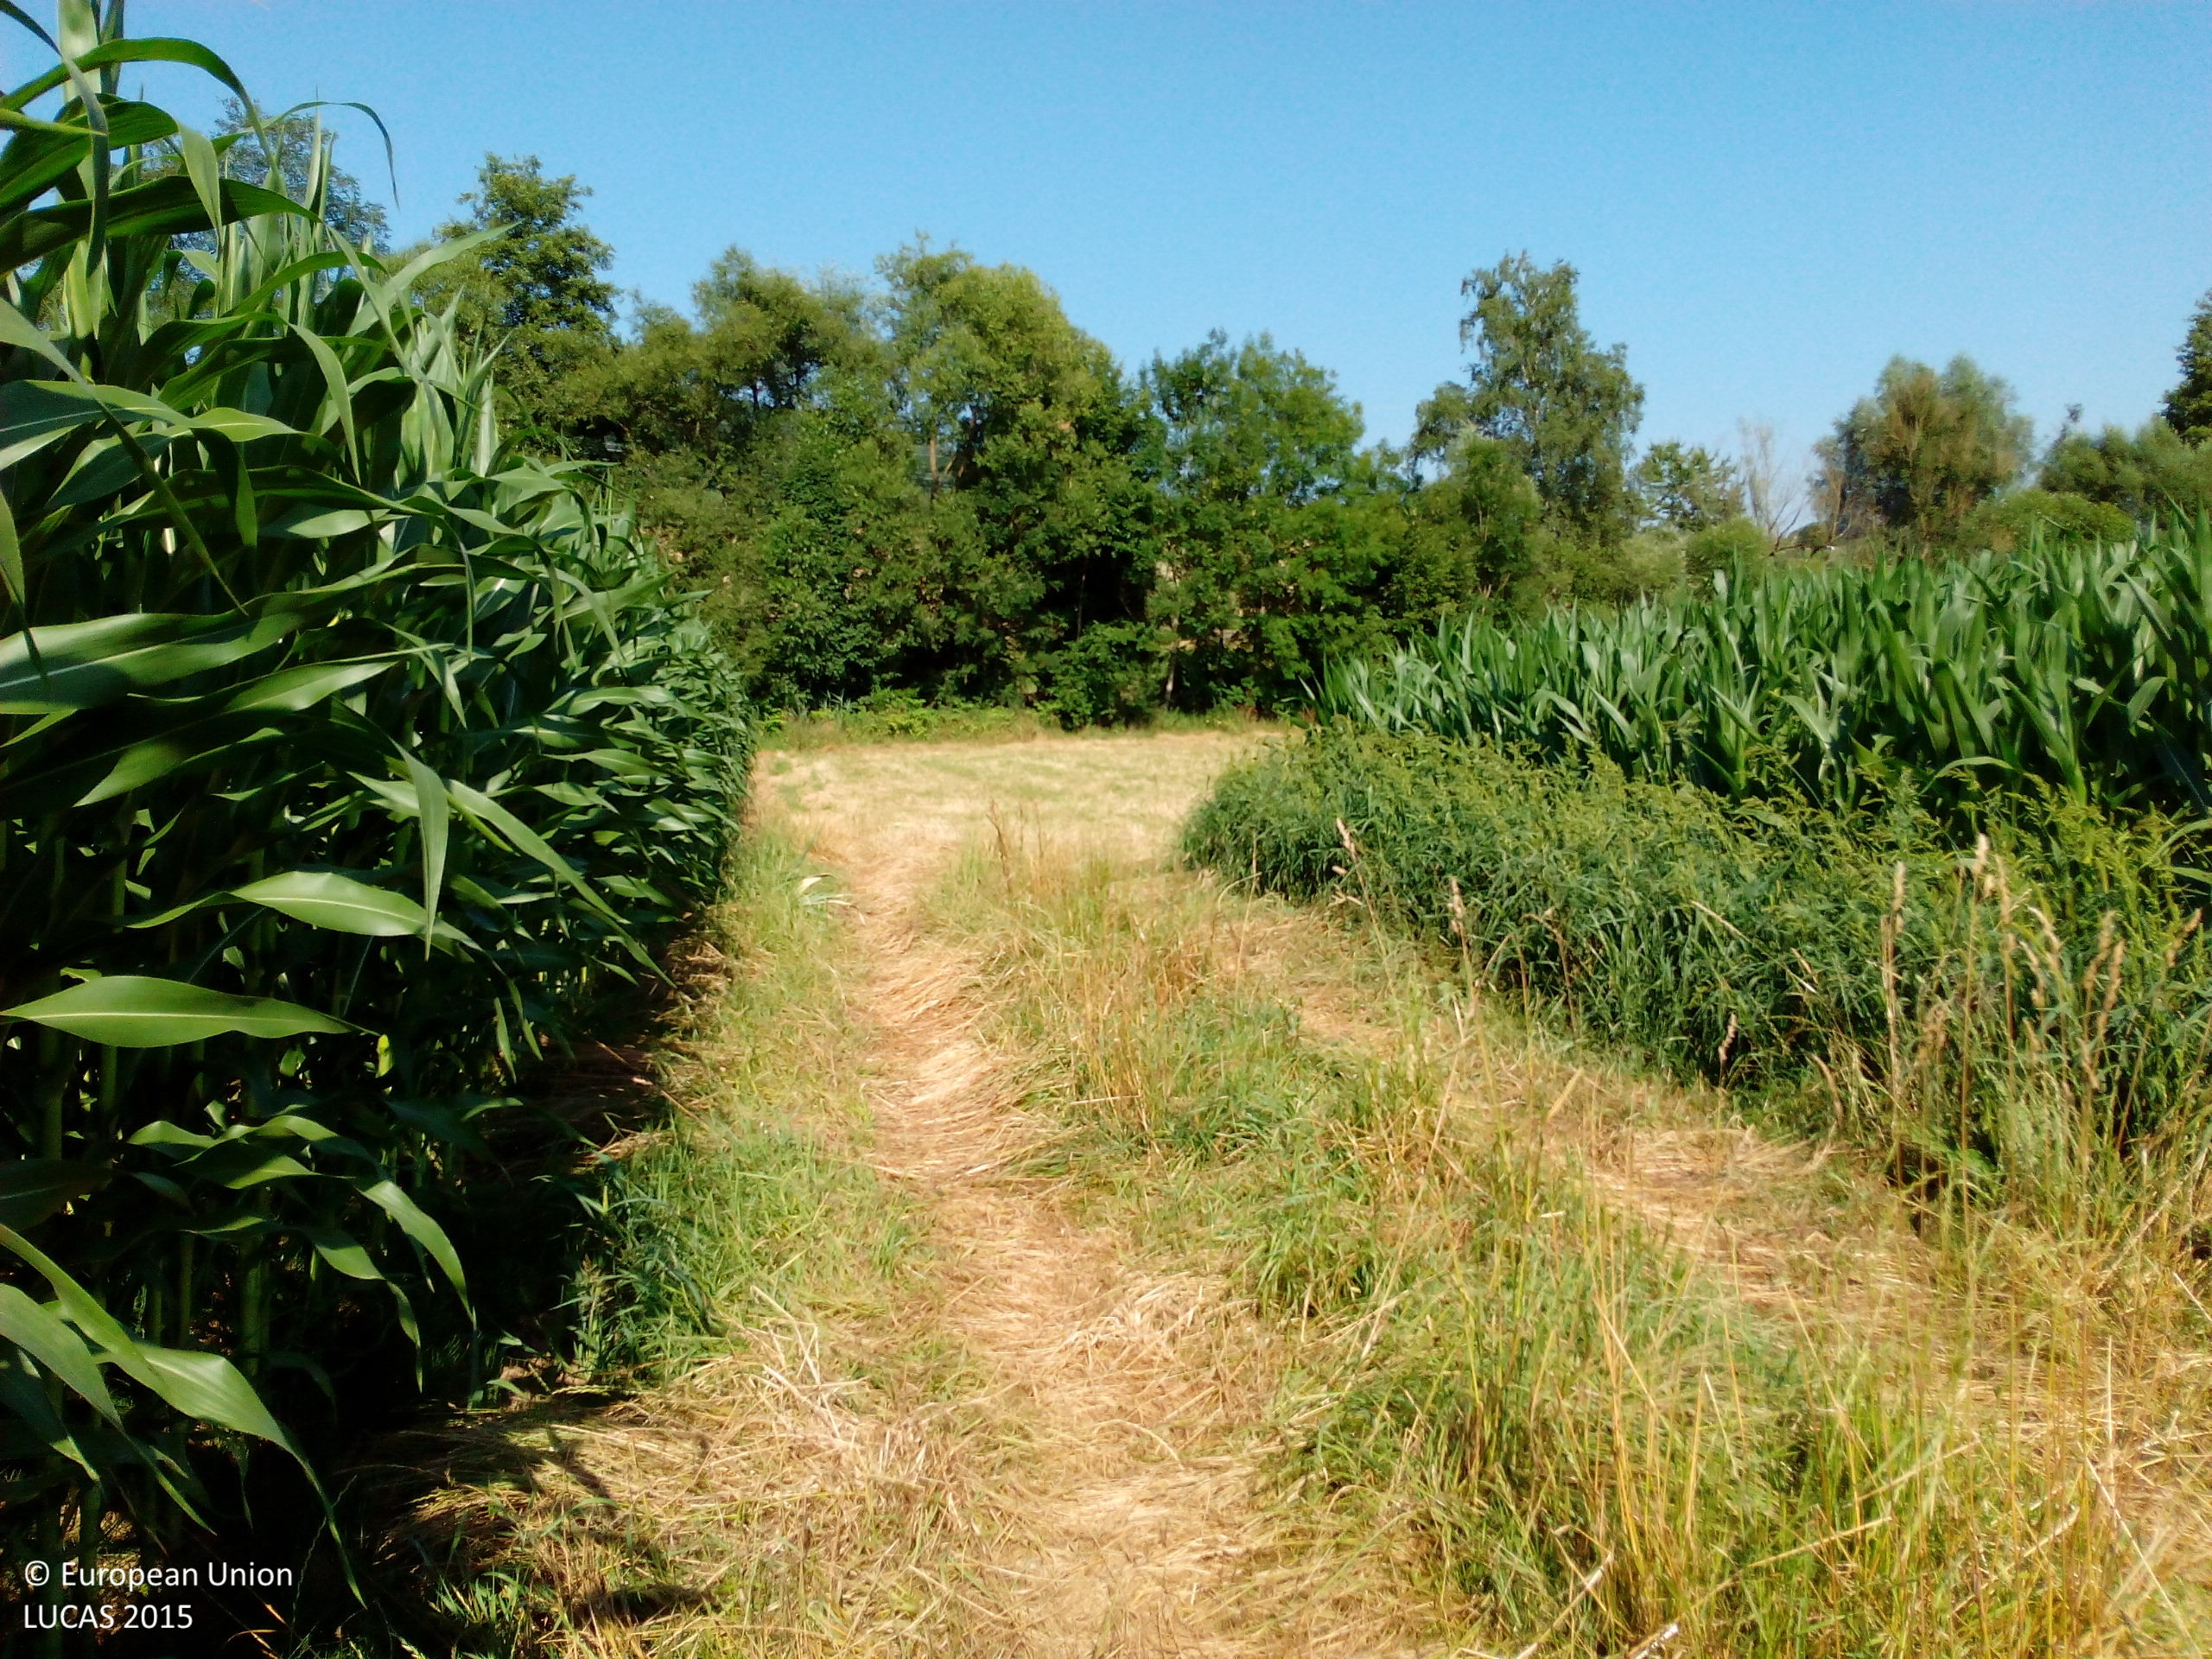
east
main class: Cropland
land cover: Maize
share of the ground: > 75 %
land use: Agriculture (excluding fallow land and kitchen gardens)
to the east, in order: Maize; Tracks; Grassland without tree/shrub cover; Shruby margins; Broadleaved woodland; Rivers and streams; Broadleaved woodland; Arable land (only in case pi); Spontaneously vegetated surfaces; Tracks; Common wheat; Spontaneously vegetated surfaces; Railways; Grassland without tree/shrub cover; Paved roads, cycling and walking lanes; Grass margins; Ditches and canals; Grass margins; Floriculture and ornamental plants; Grass margins; Paved roads, cycling and walking lanes; Grass margins; Oats
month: July
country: DE
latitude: 47.6763
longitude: 7.6439
